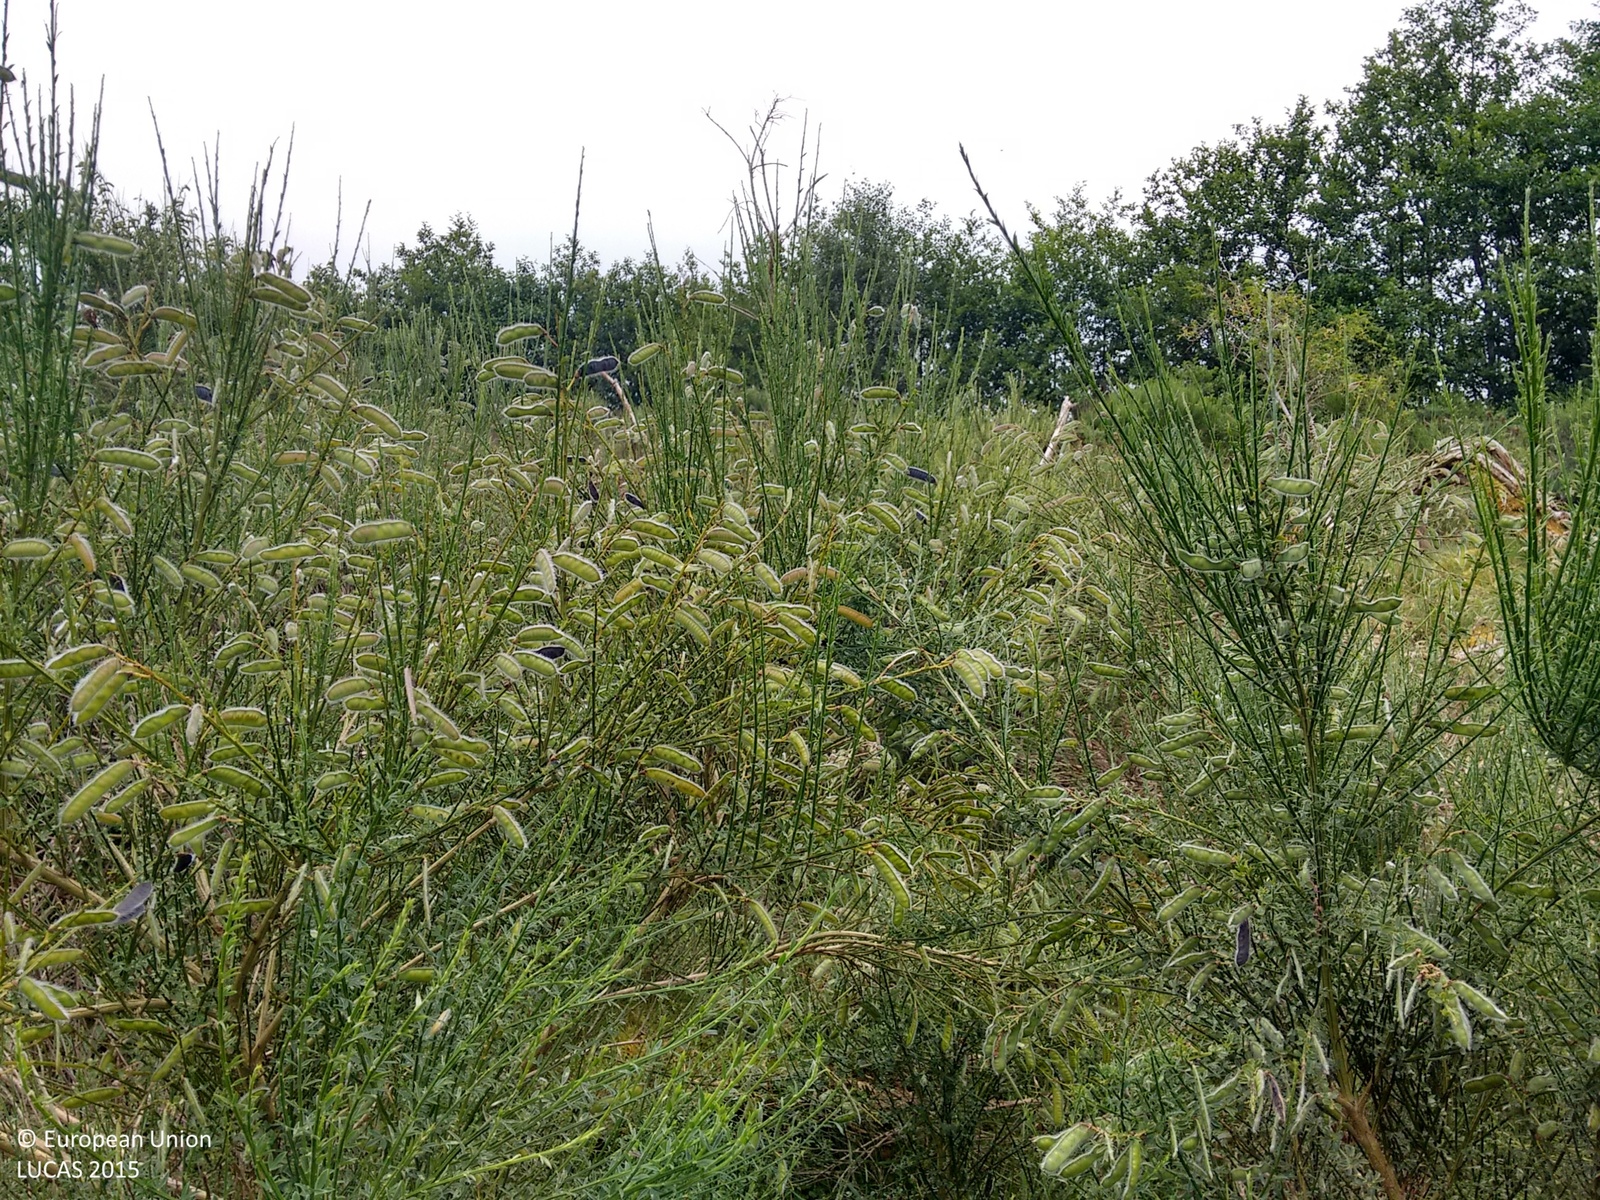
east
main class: Shrubland
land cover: Shrubland with sparse tree cover
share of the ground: > 75 %
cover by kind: shrubs 85 %, herbaceous plants 10 %, coniferous forest trees 5 %
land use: Agriculture (excluding fallow land and kitchen gardens)
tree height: > 5 m
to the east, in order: Shrubland with sparse tree cover; Fences; Shrubland with sparse tree cover; Lines of trees; Sand; Inland fresh running water; Shrubland without tree cover; Grassland without tree/shrub cover; Fences; Grassland without tree/shrub cover; Fences; Arable land (only in case pi)
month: August
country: GB
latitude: 57.5363
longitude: -4.5064
